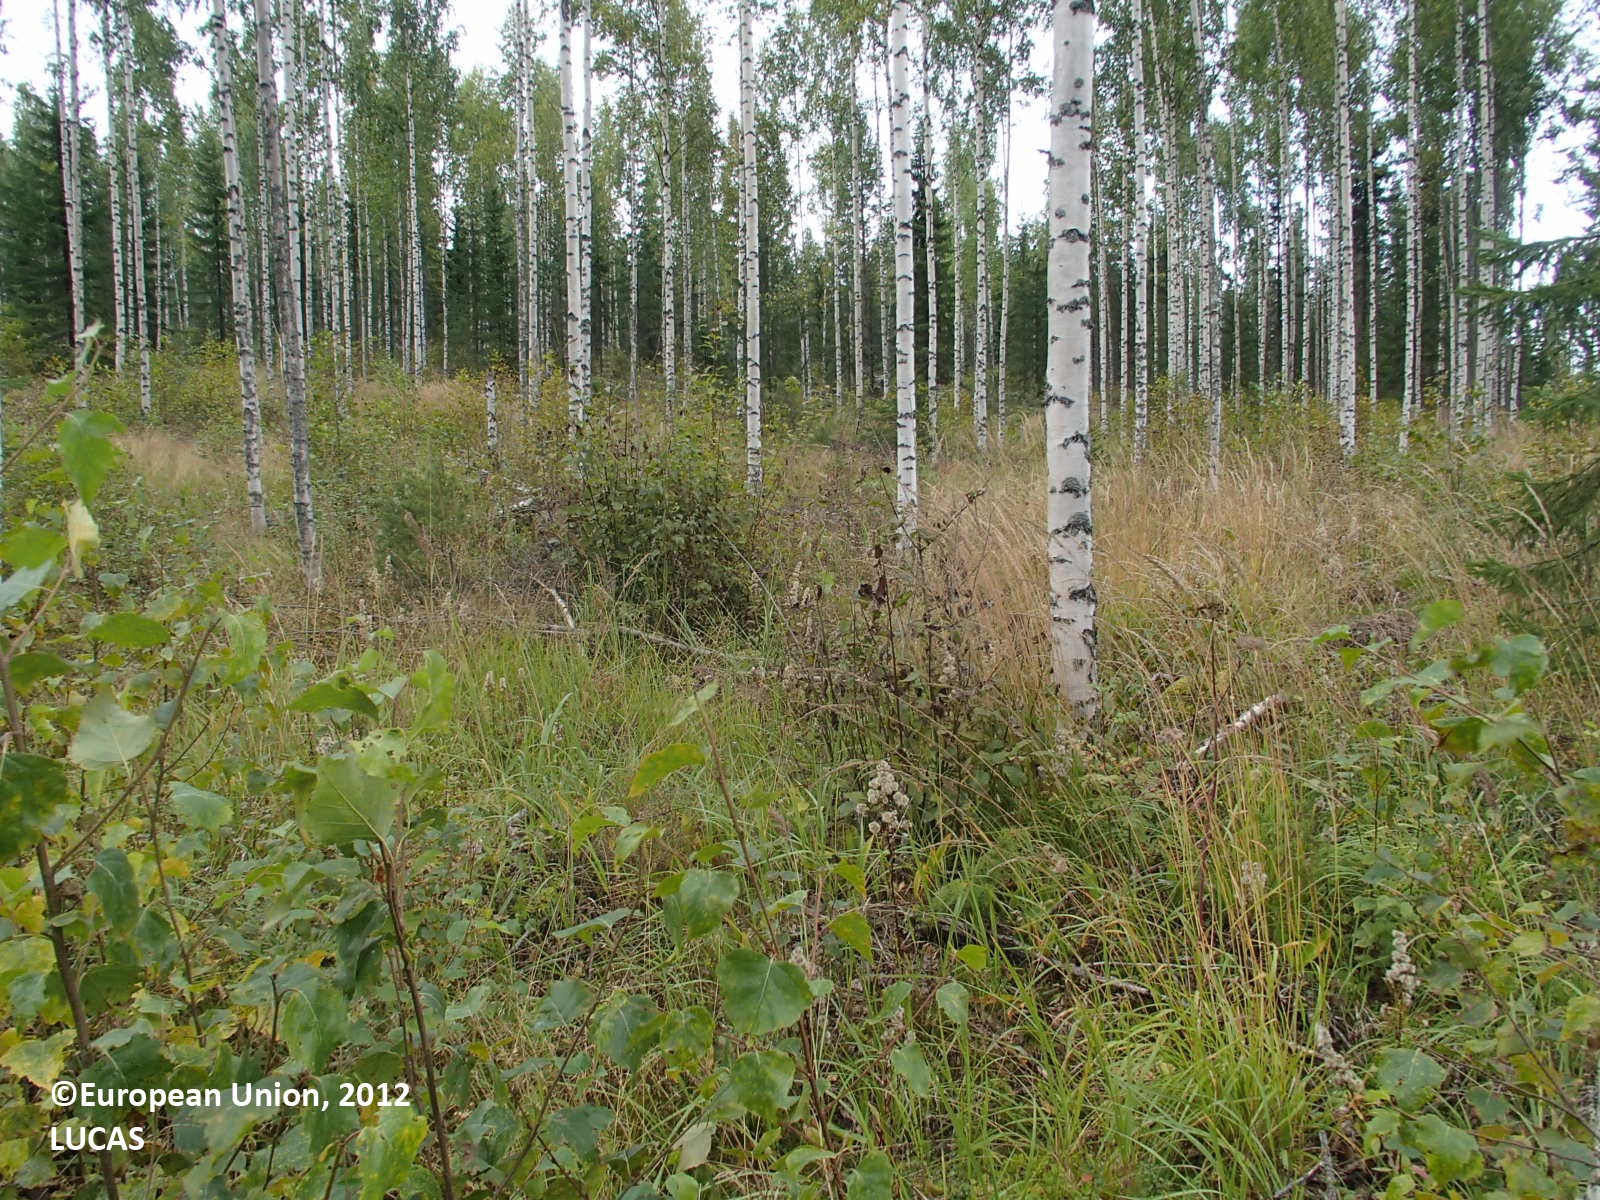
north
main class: Woodland
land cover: Spruce dominated mixed woodland
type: boreal forest
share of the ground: > 75 %
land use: Forestry
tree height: > 5 m
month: August
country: FI
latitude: 63.4769
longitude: 27.1046
